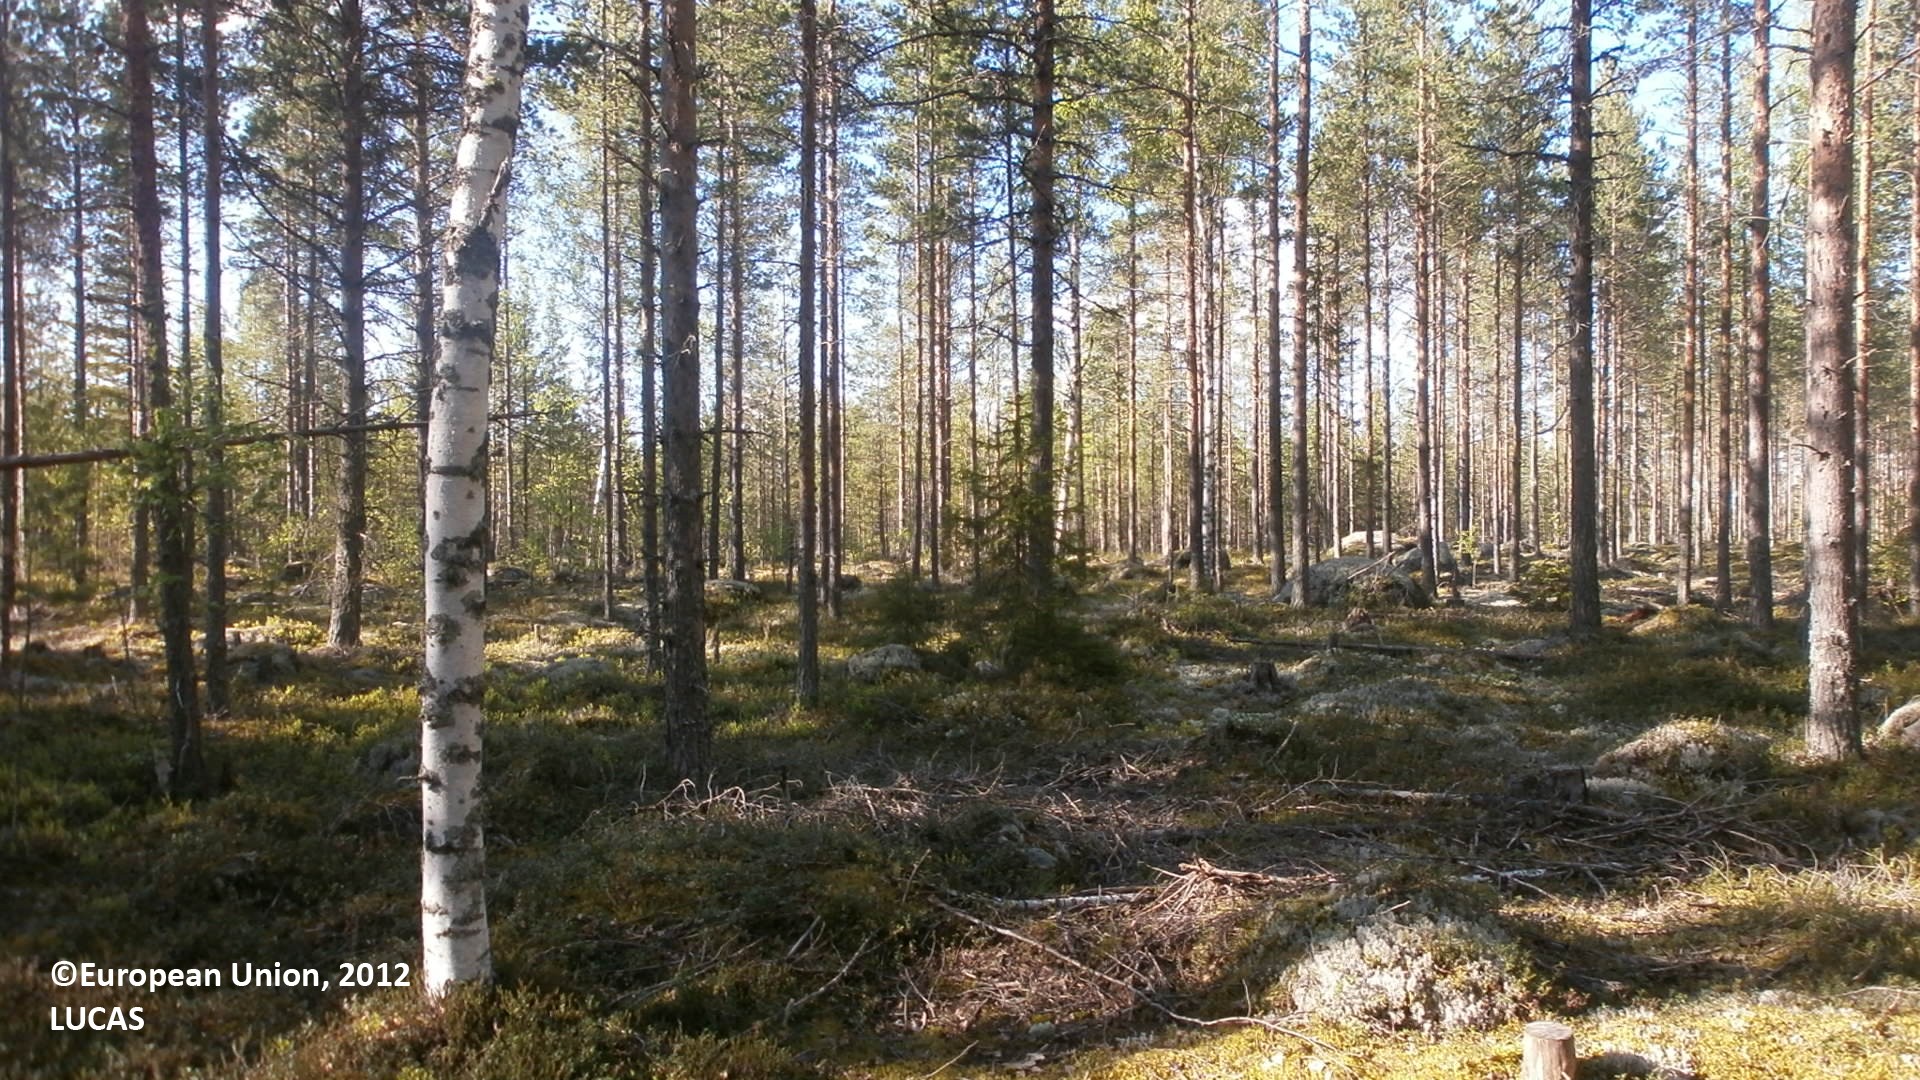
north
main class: Woodland
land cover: Pine dominated coniferous woodland
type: hemiboreal forest and nemoral coniferous forest and mixed broadleaved-coniferous forest
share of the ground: 25 - 50 %
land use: Forestry
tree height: > 5 m
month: June
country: FI
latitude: 64.5540
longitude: 25.1208
